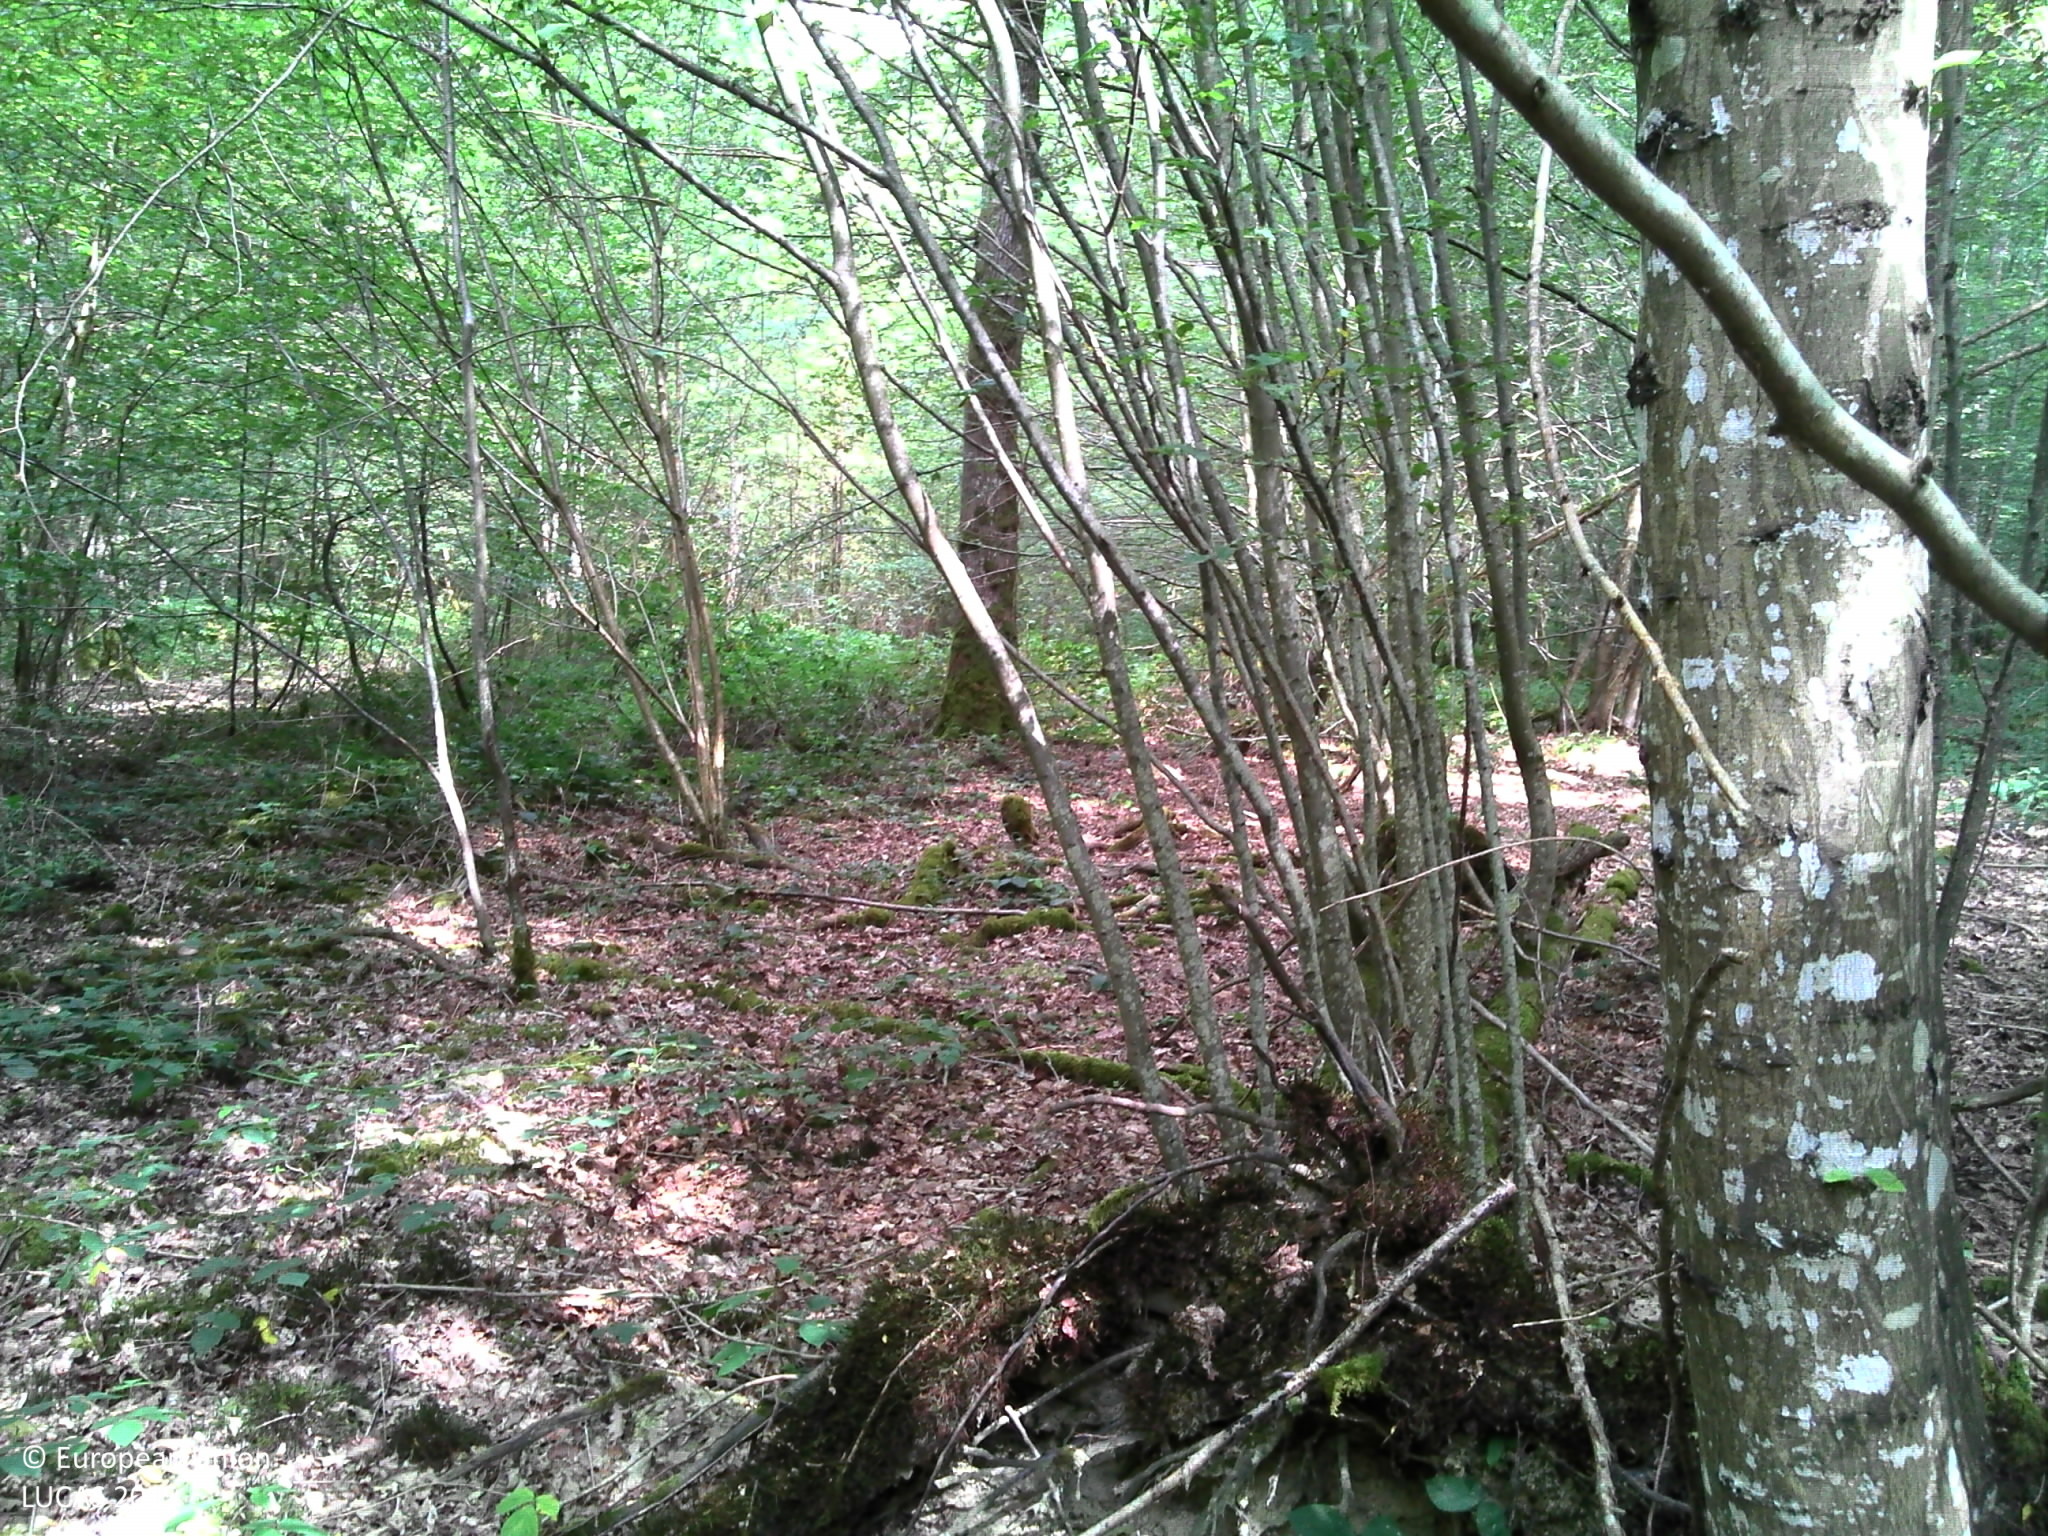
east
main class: Woodland
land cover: Broadleaved woodland
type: mesophytic deciduous forest
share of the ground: > 75 %
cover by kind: broadleaved forest trees 90 %, herbaceous plants 5 %, lichens and mosses 5 %
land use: Forestry
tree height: > 5 m
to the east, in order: Broadleaved woodland; Ditches and canals; Broadleaved woodland
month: July
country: FR
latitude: 48.0766
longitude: 3.0536
